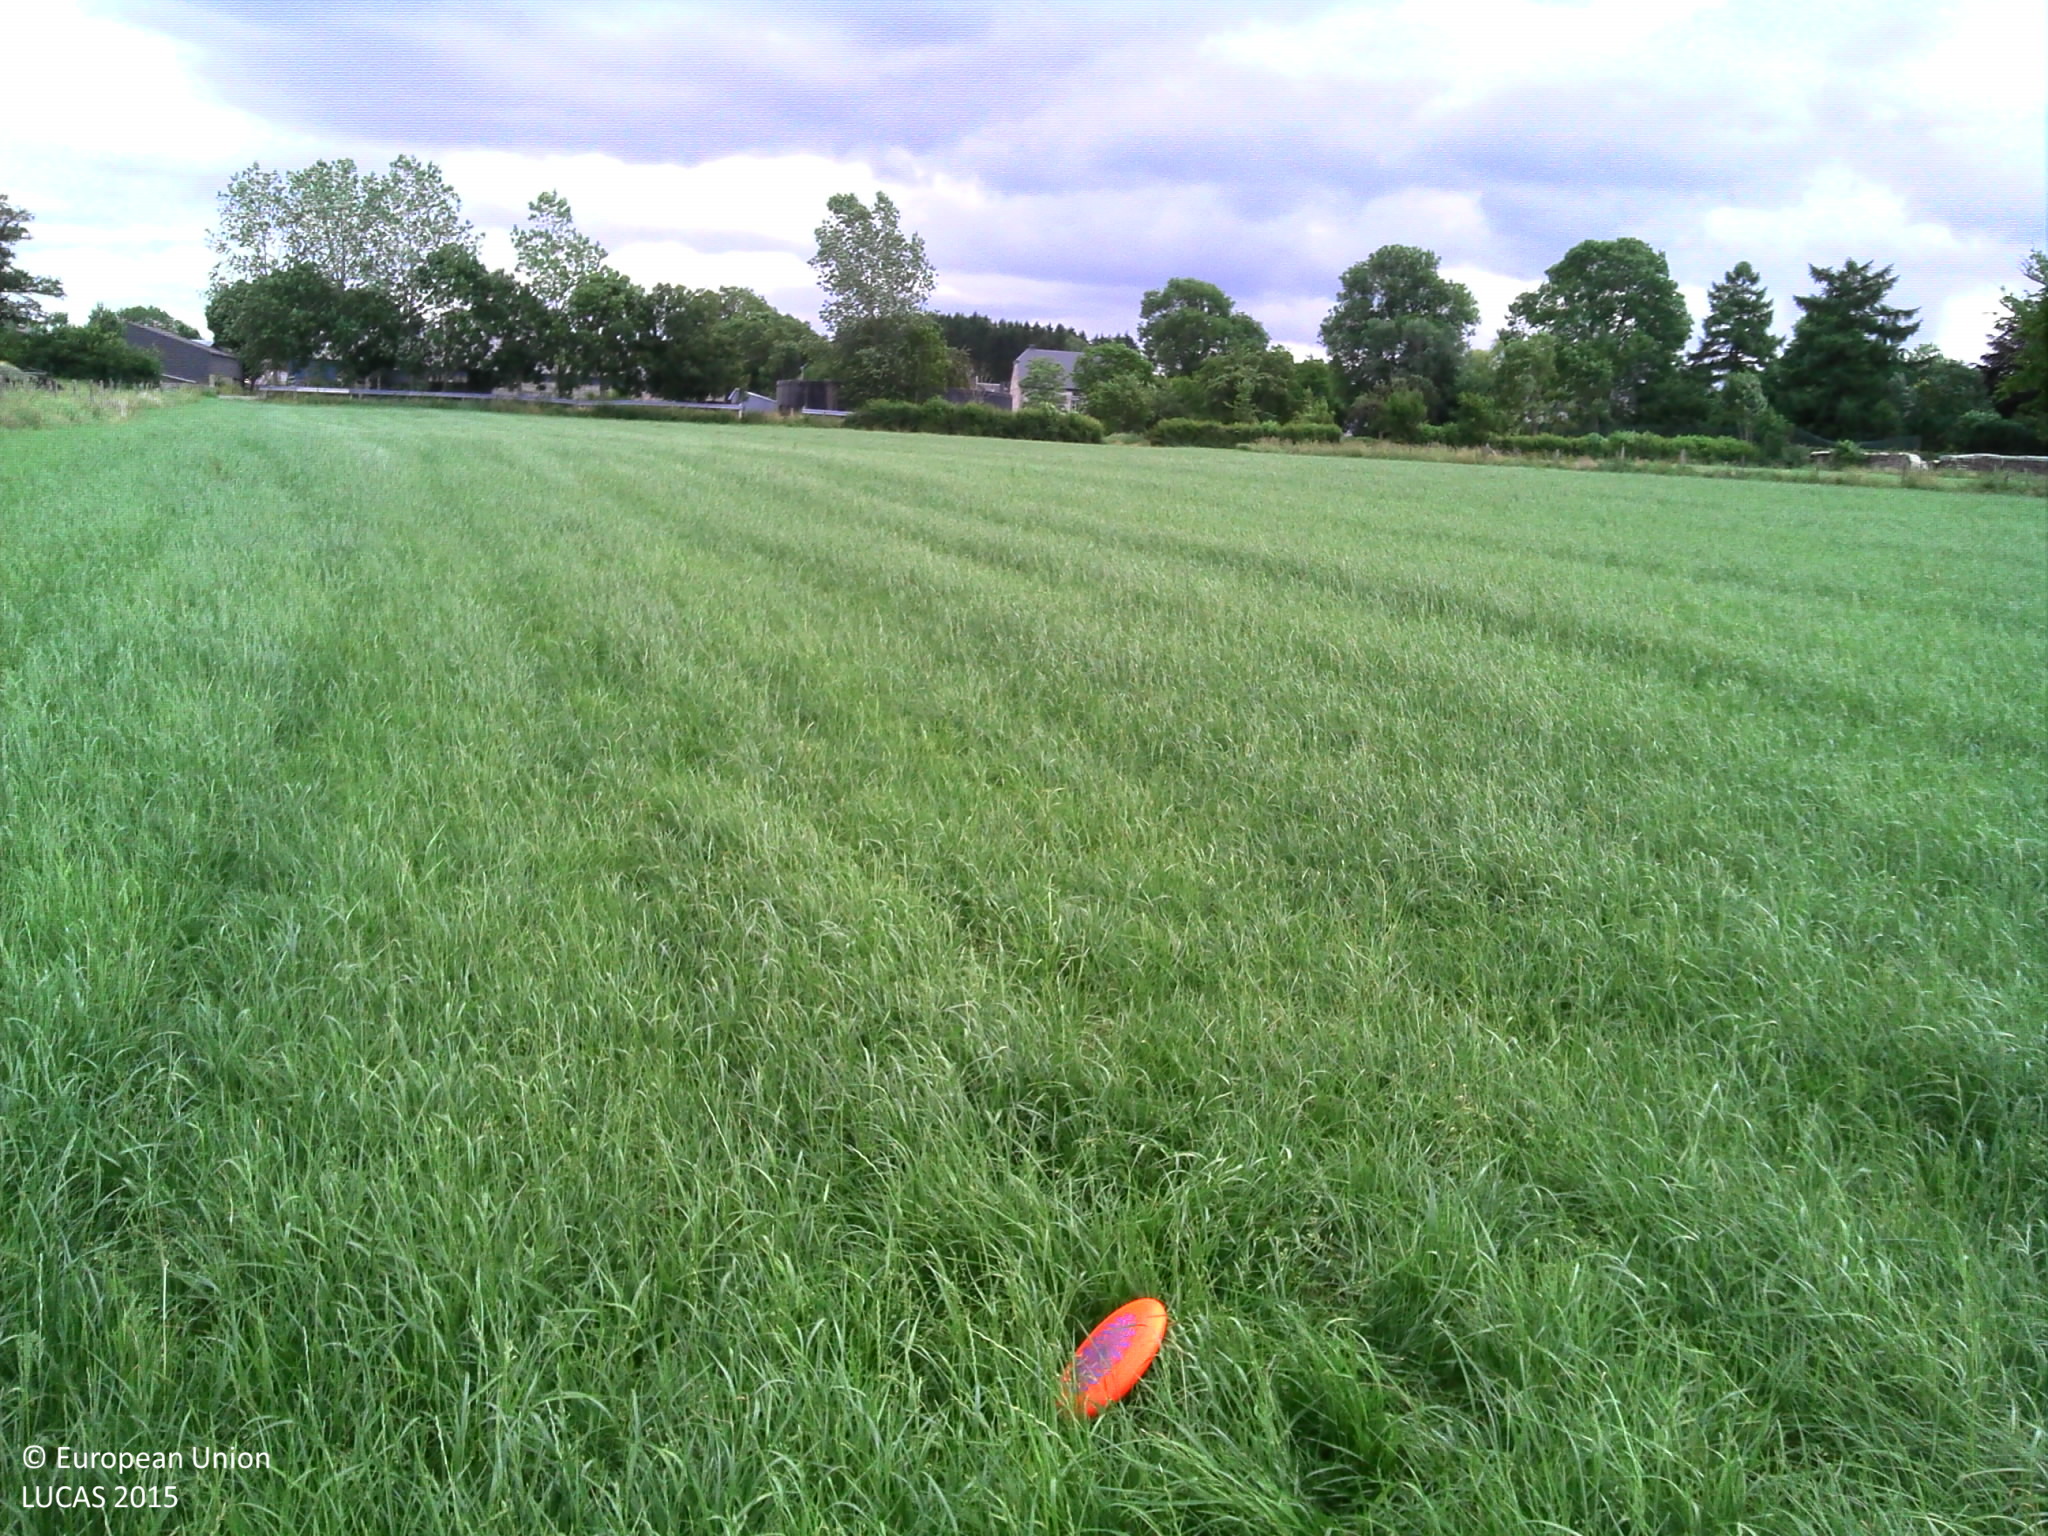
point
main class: Grassland
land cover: Grassland without tree/shrub cover
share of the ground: > 75 %
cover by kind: herbaceous plants 100 %
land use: Agriculture (excluding fallow land and kitchen gardens)
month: July
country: BE
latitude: 50.1465
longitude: 5.8987
